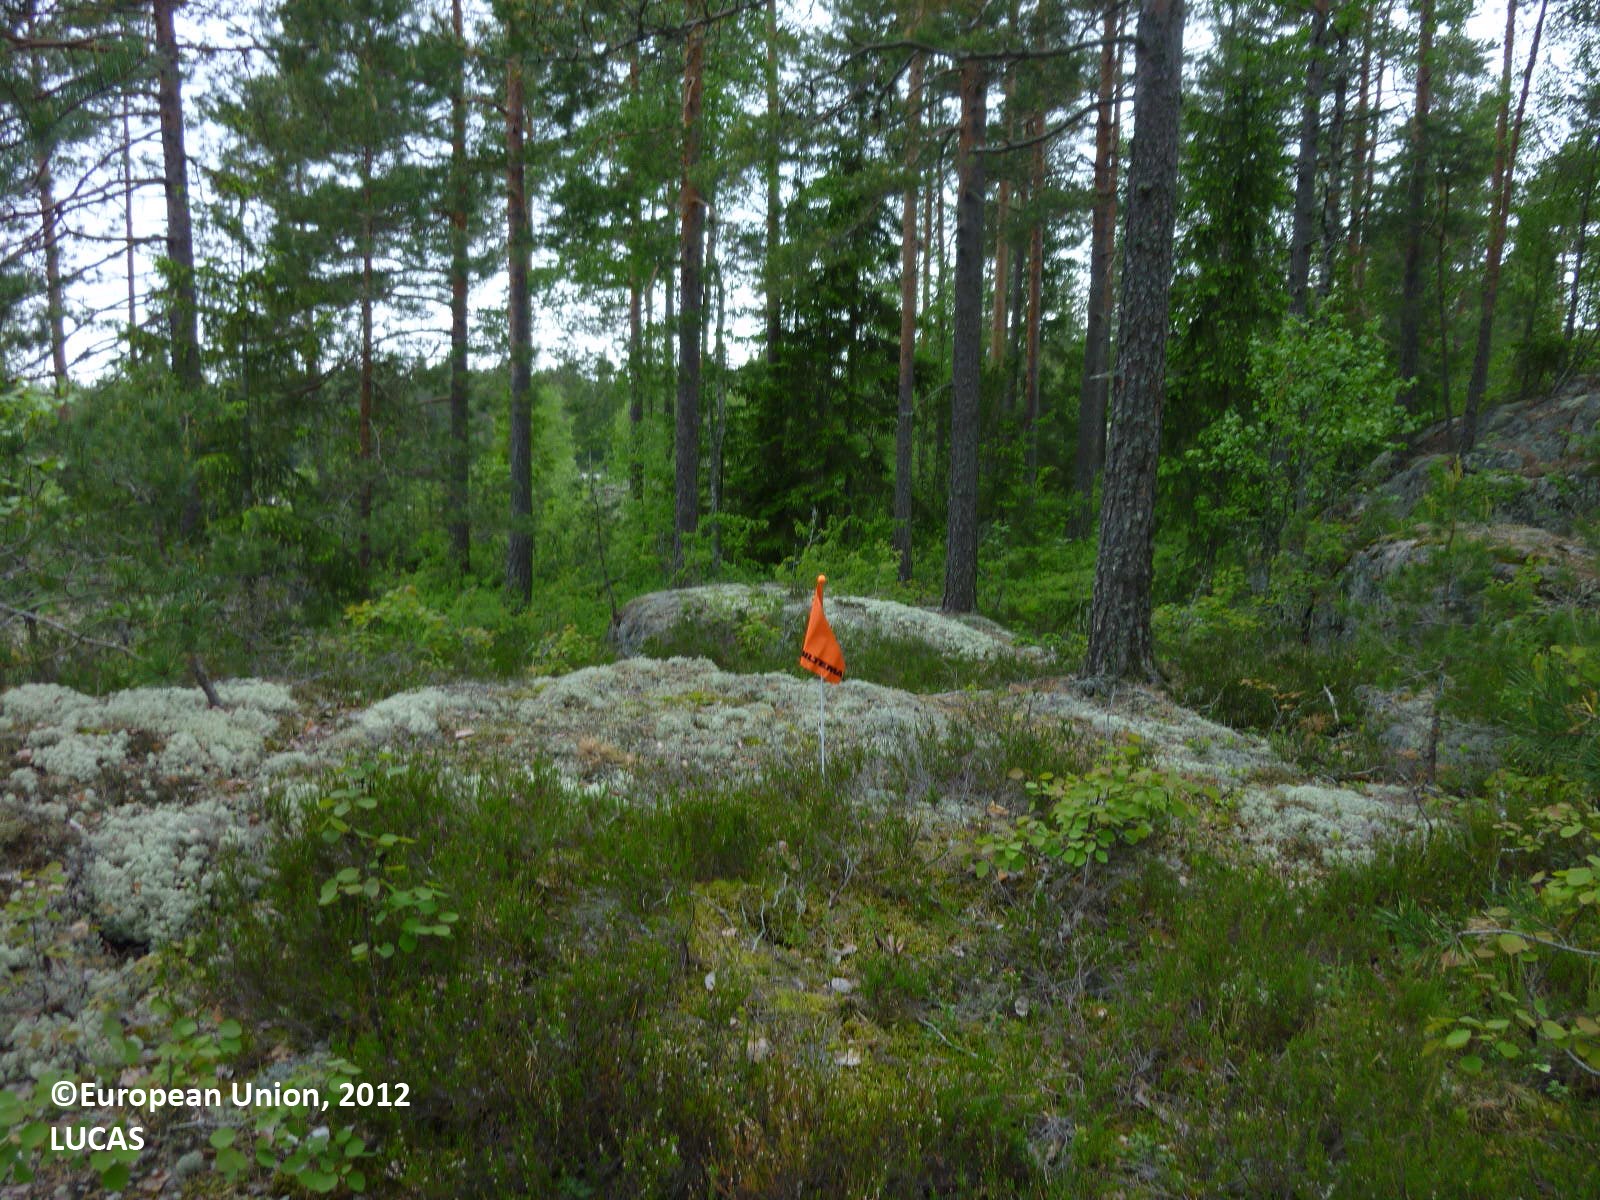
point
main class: Woodland
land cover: Pine dominated coniferous woodland
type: boreal forest
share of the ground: 25 - 50 %
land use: Forestry
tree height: > 5 m
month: June
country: FI
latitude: 60.3763
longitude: 22.6417
